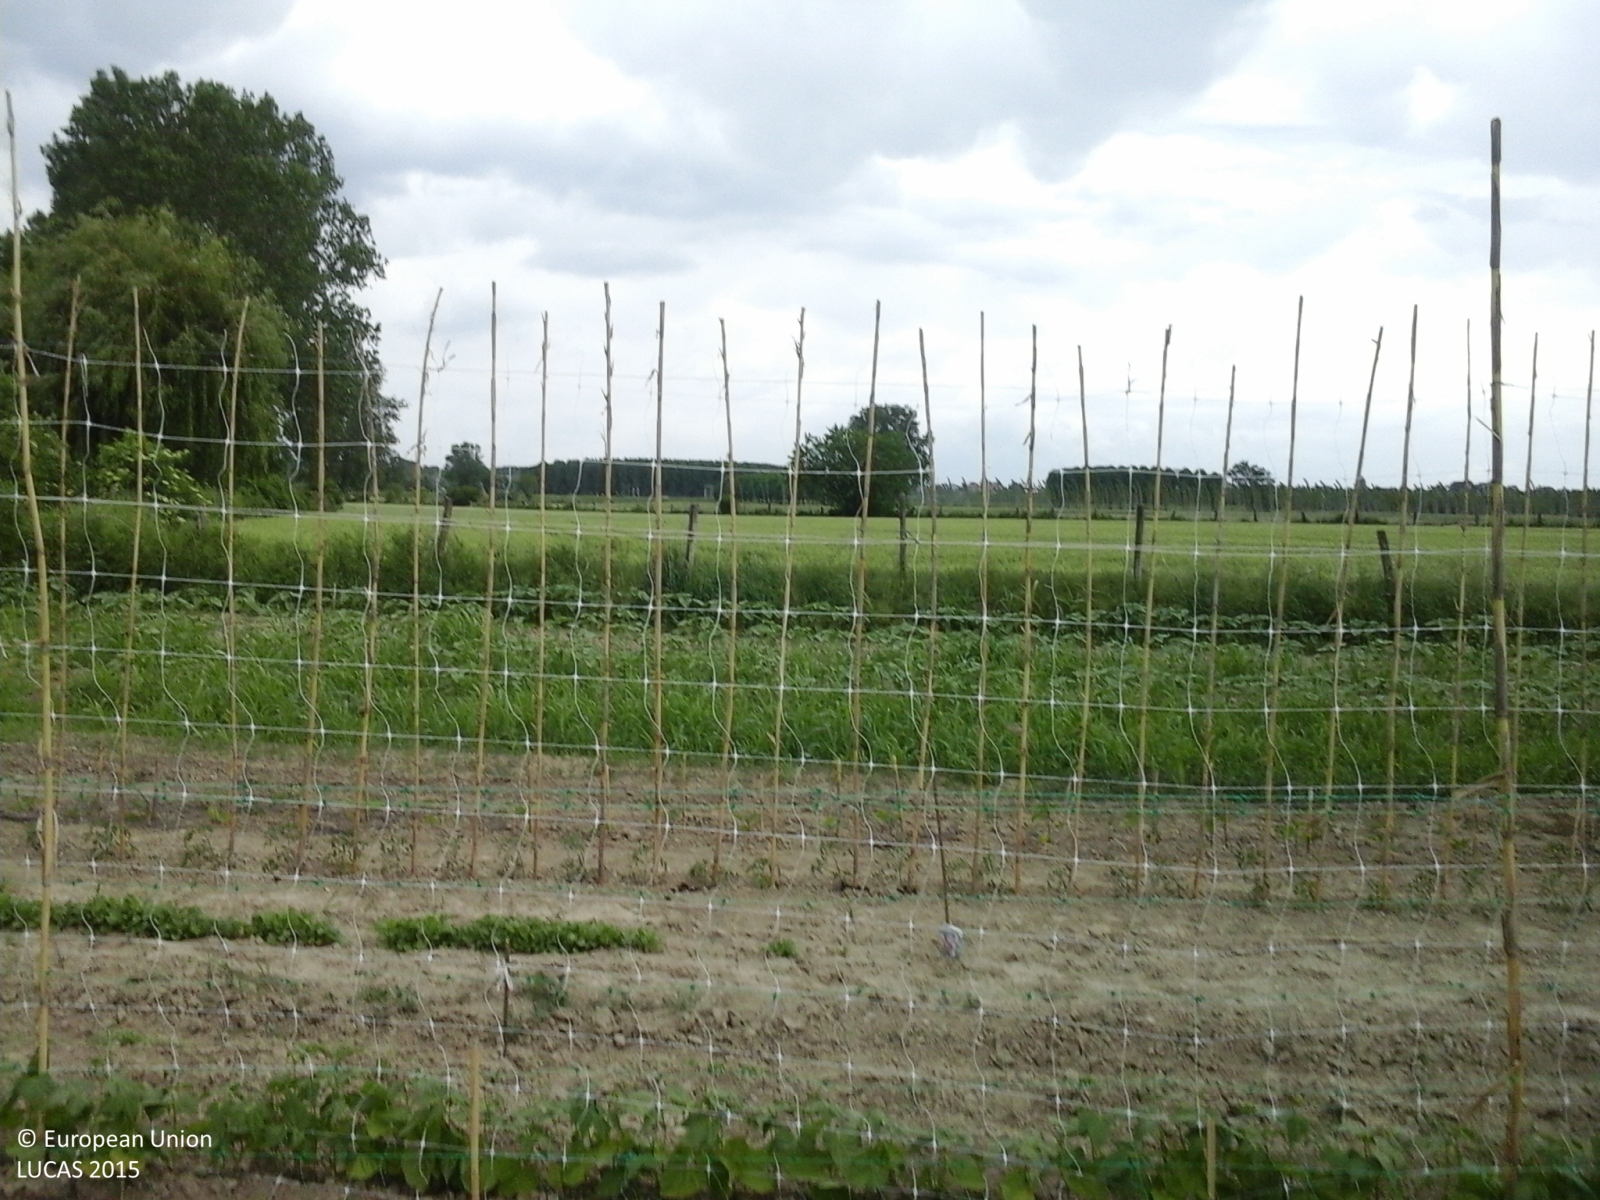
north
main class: Cropland
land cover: Other fresh vegetables
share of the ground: < 10 %
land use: Kitchen garden
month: May
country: IT
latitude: 44.8796
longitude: 8.4207
